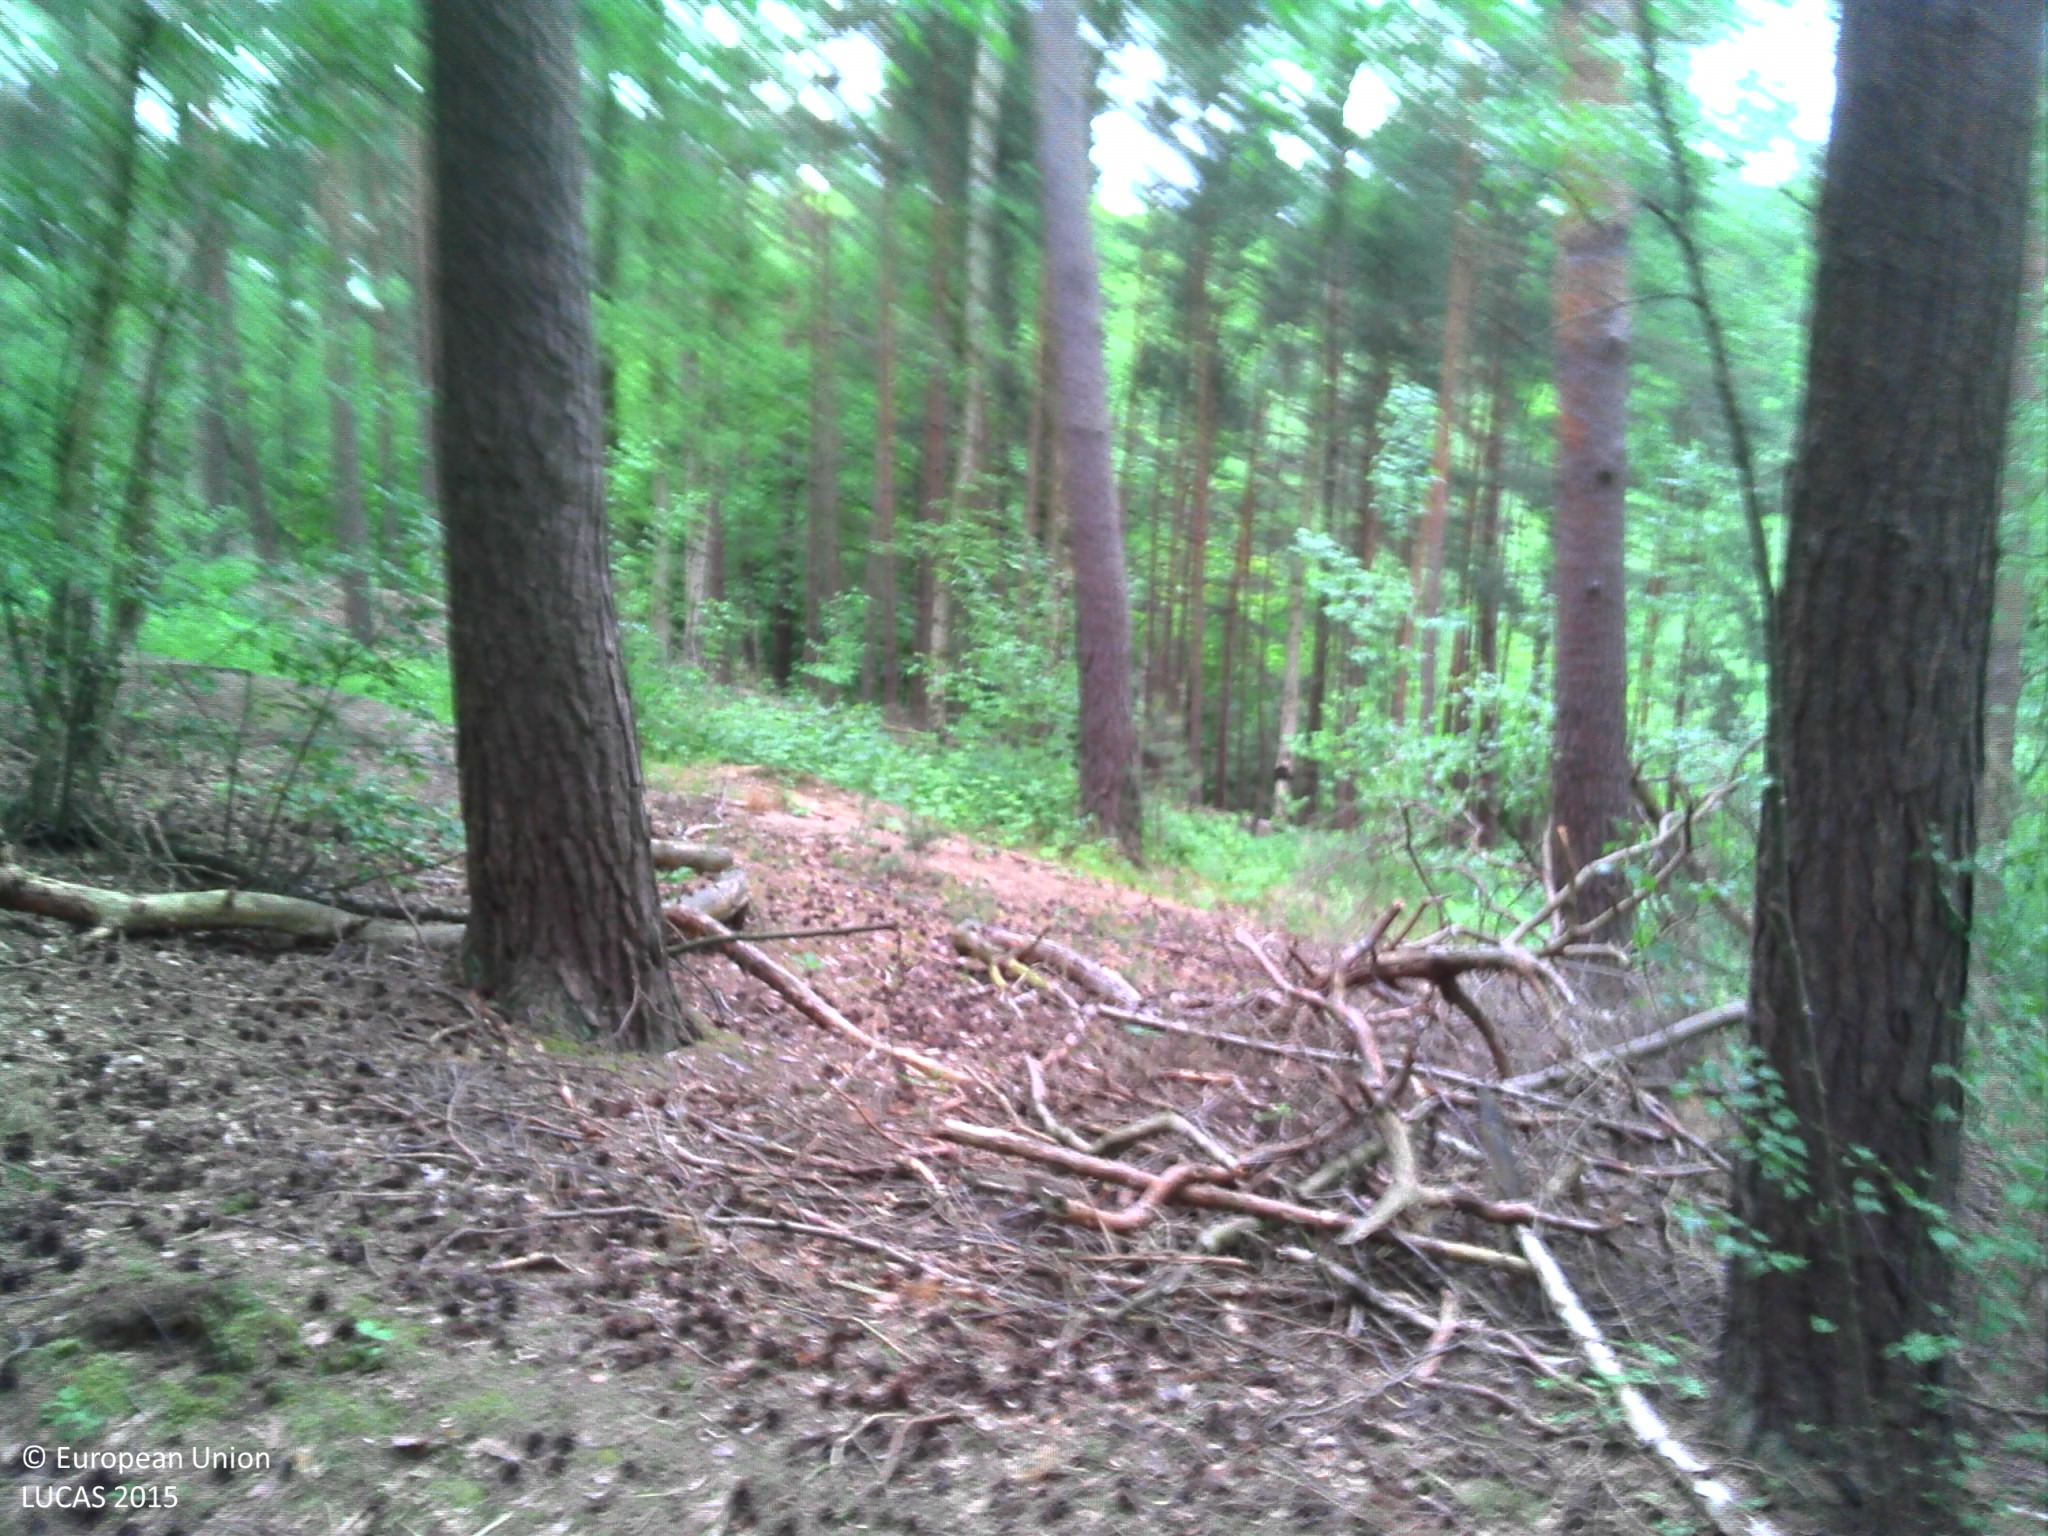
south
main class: Woodland
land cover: Pine dominated coniferous woodland
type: exotic forest
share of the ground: > 75 %
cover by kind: coniferous forest trees 100 %
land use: Forestry
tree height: > 5 m
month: May
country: BE
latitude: 50.7204
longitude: 4.5426
